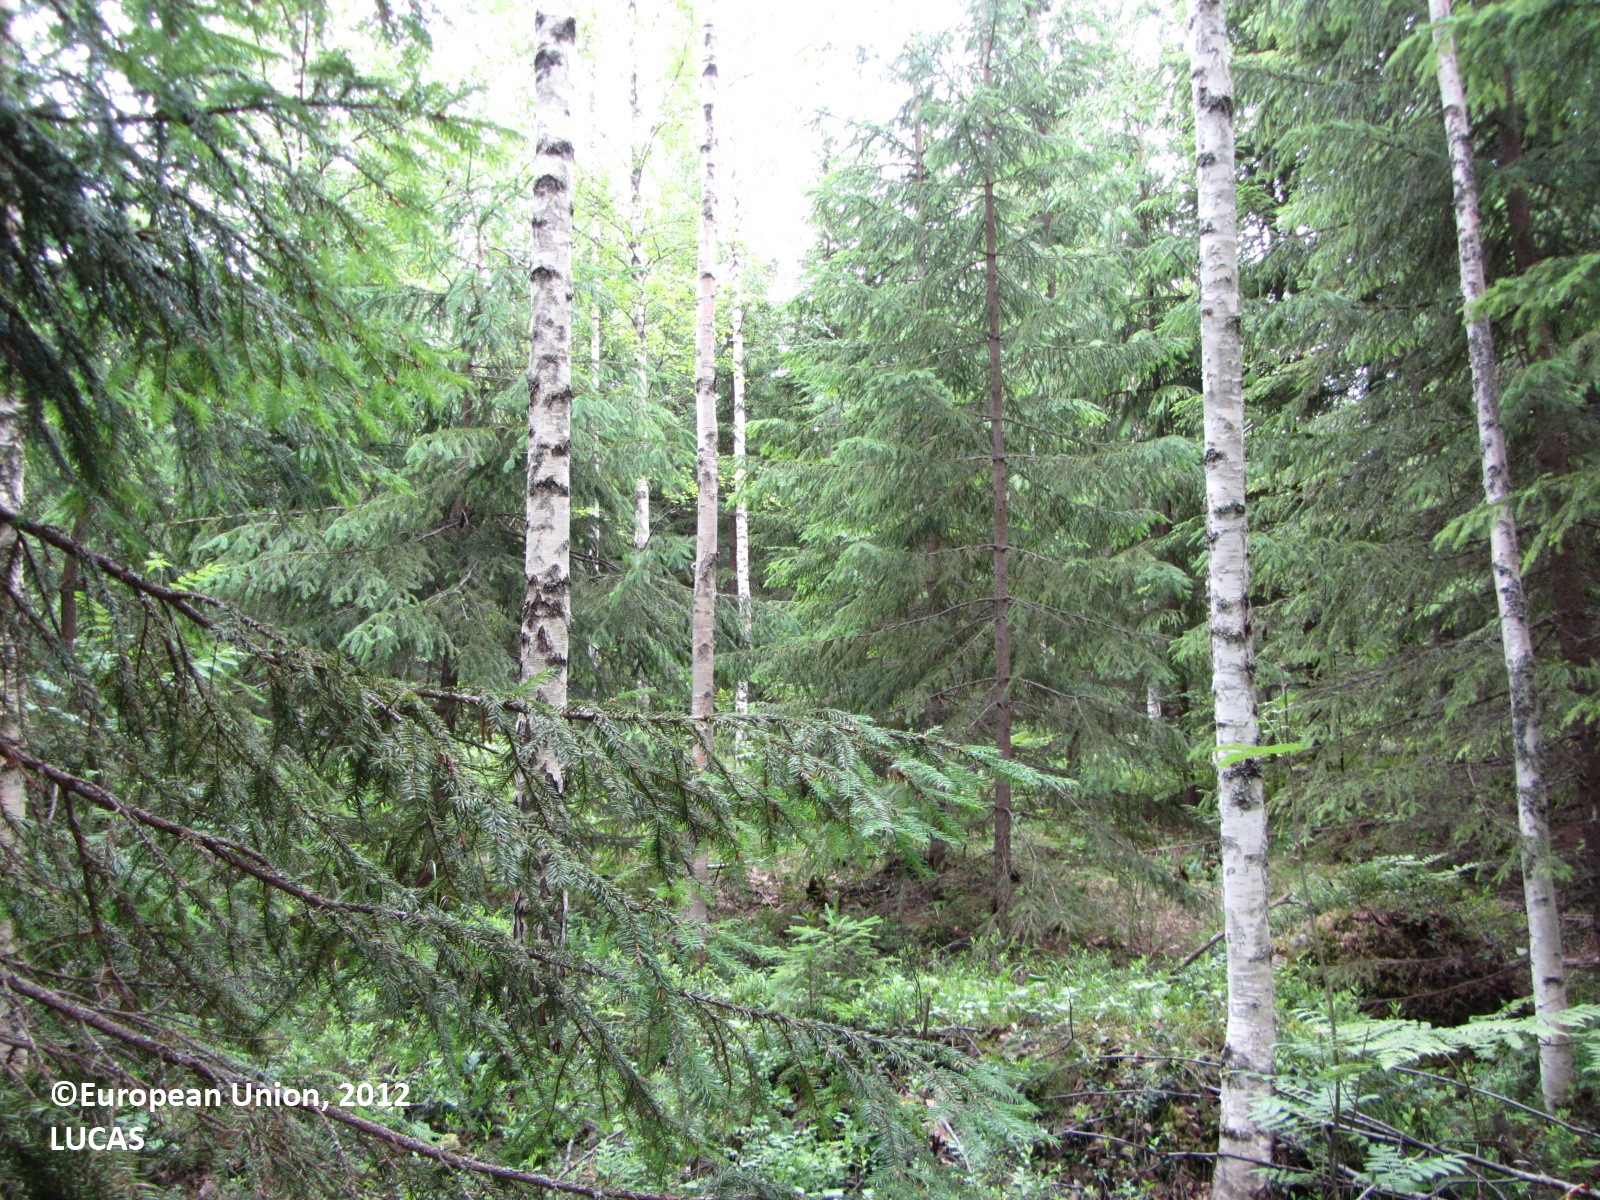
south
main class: Woodland
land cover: Spruce dominated mixed woodland
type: boreal forest
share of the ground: > 75 %
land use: Forestry
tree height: > 5 m
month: June
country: FI
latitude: 62.6465
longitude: 25.5424
